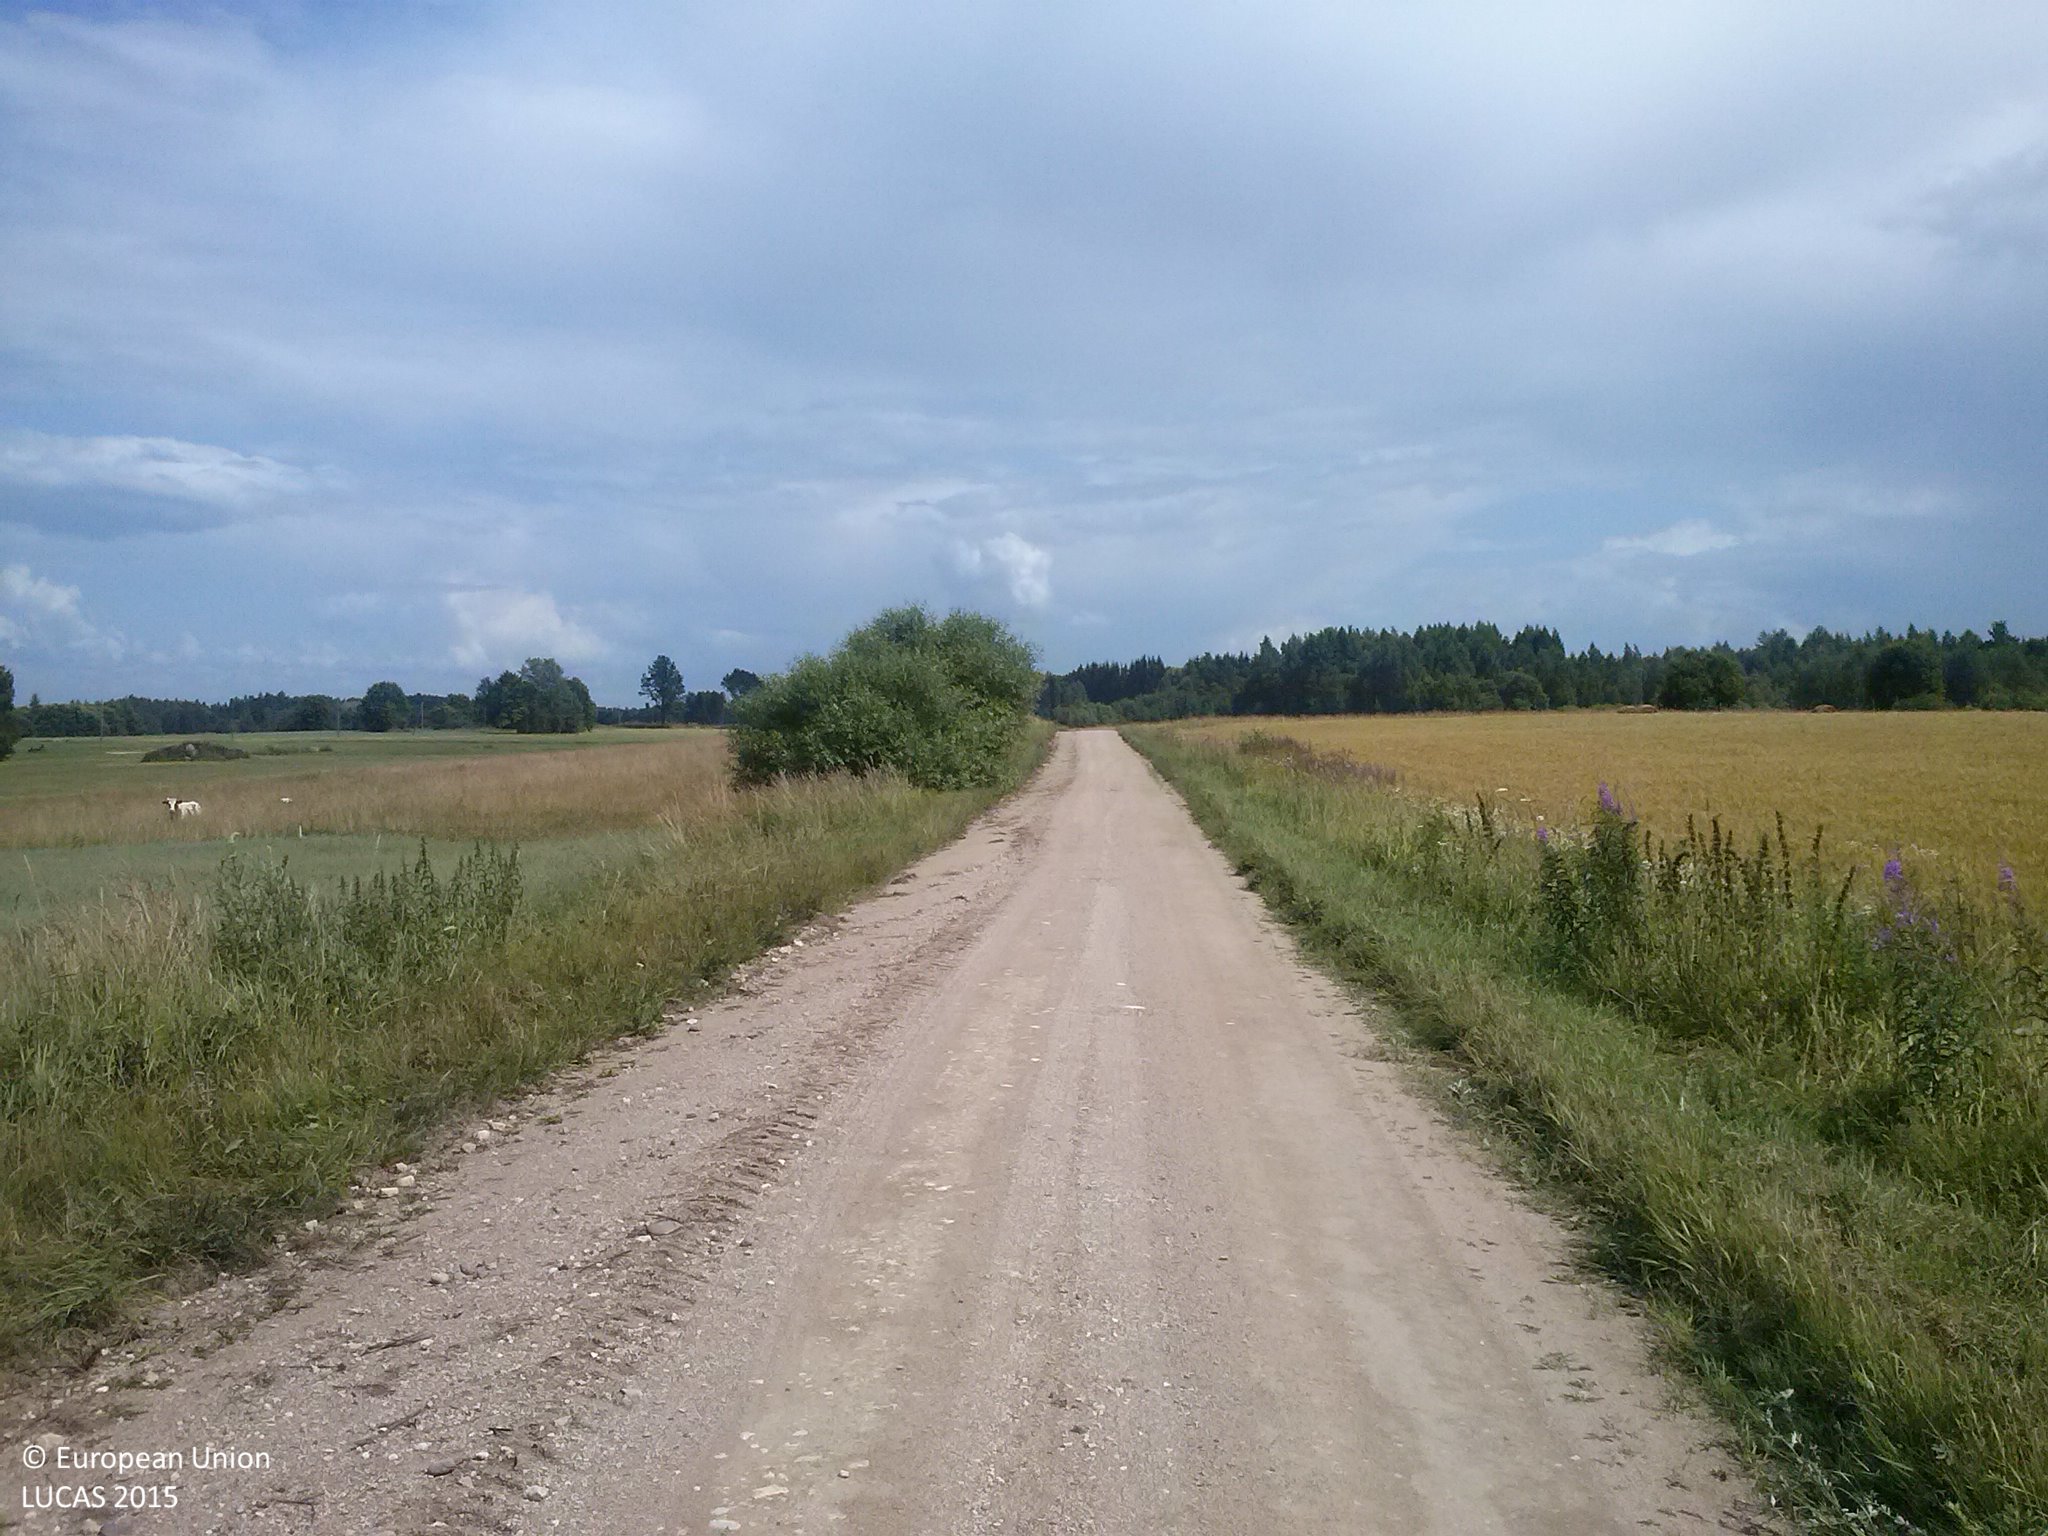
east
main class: Cropland
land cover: Durum wheat
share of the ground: > 75 %
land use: Agriculture (excluding fallow land and kitchen gardens)
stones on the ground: < 10 %
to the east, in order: Durum wheat; Grassland without tree/shrub cover; Tracks; Grass margins; Ditches and canals; Grassland without tree/shrub cover
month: July
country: LV
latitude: 56.7176
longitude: 27.5482
